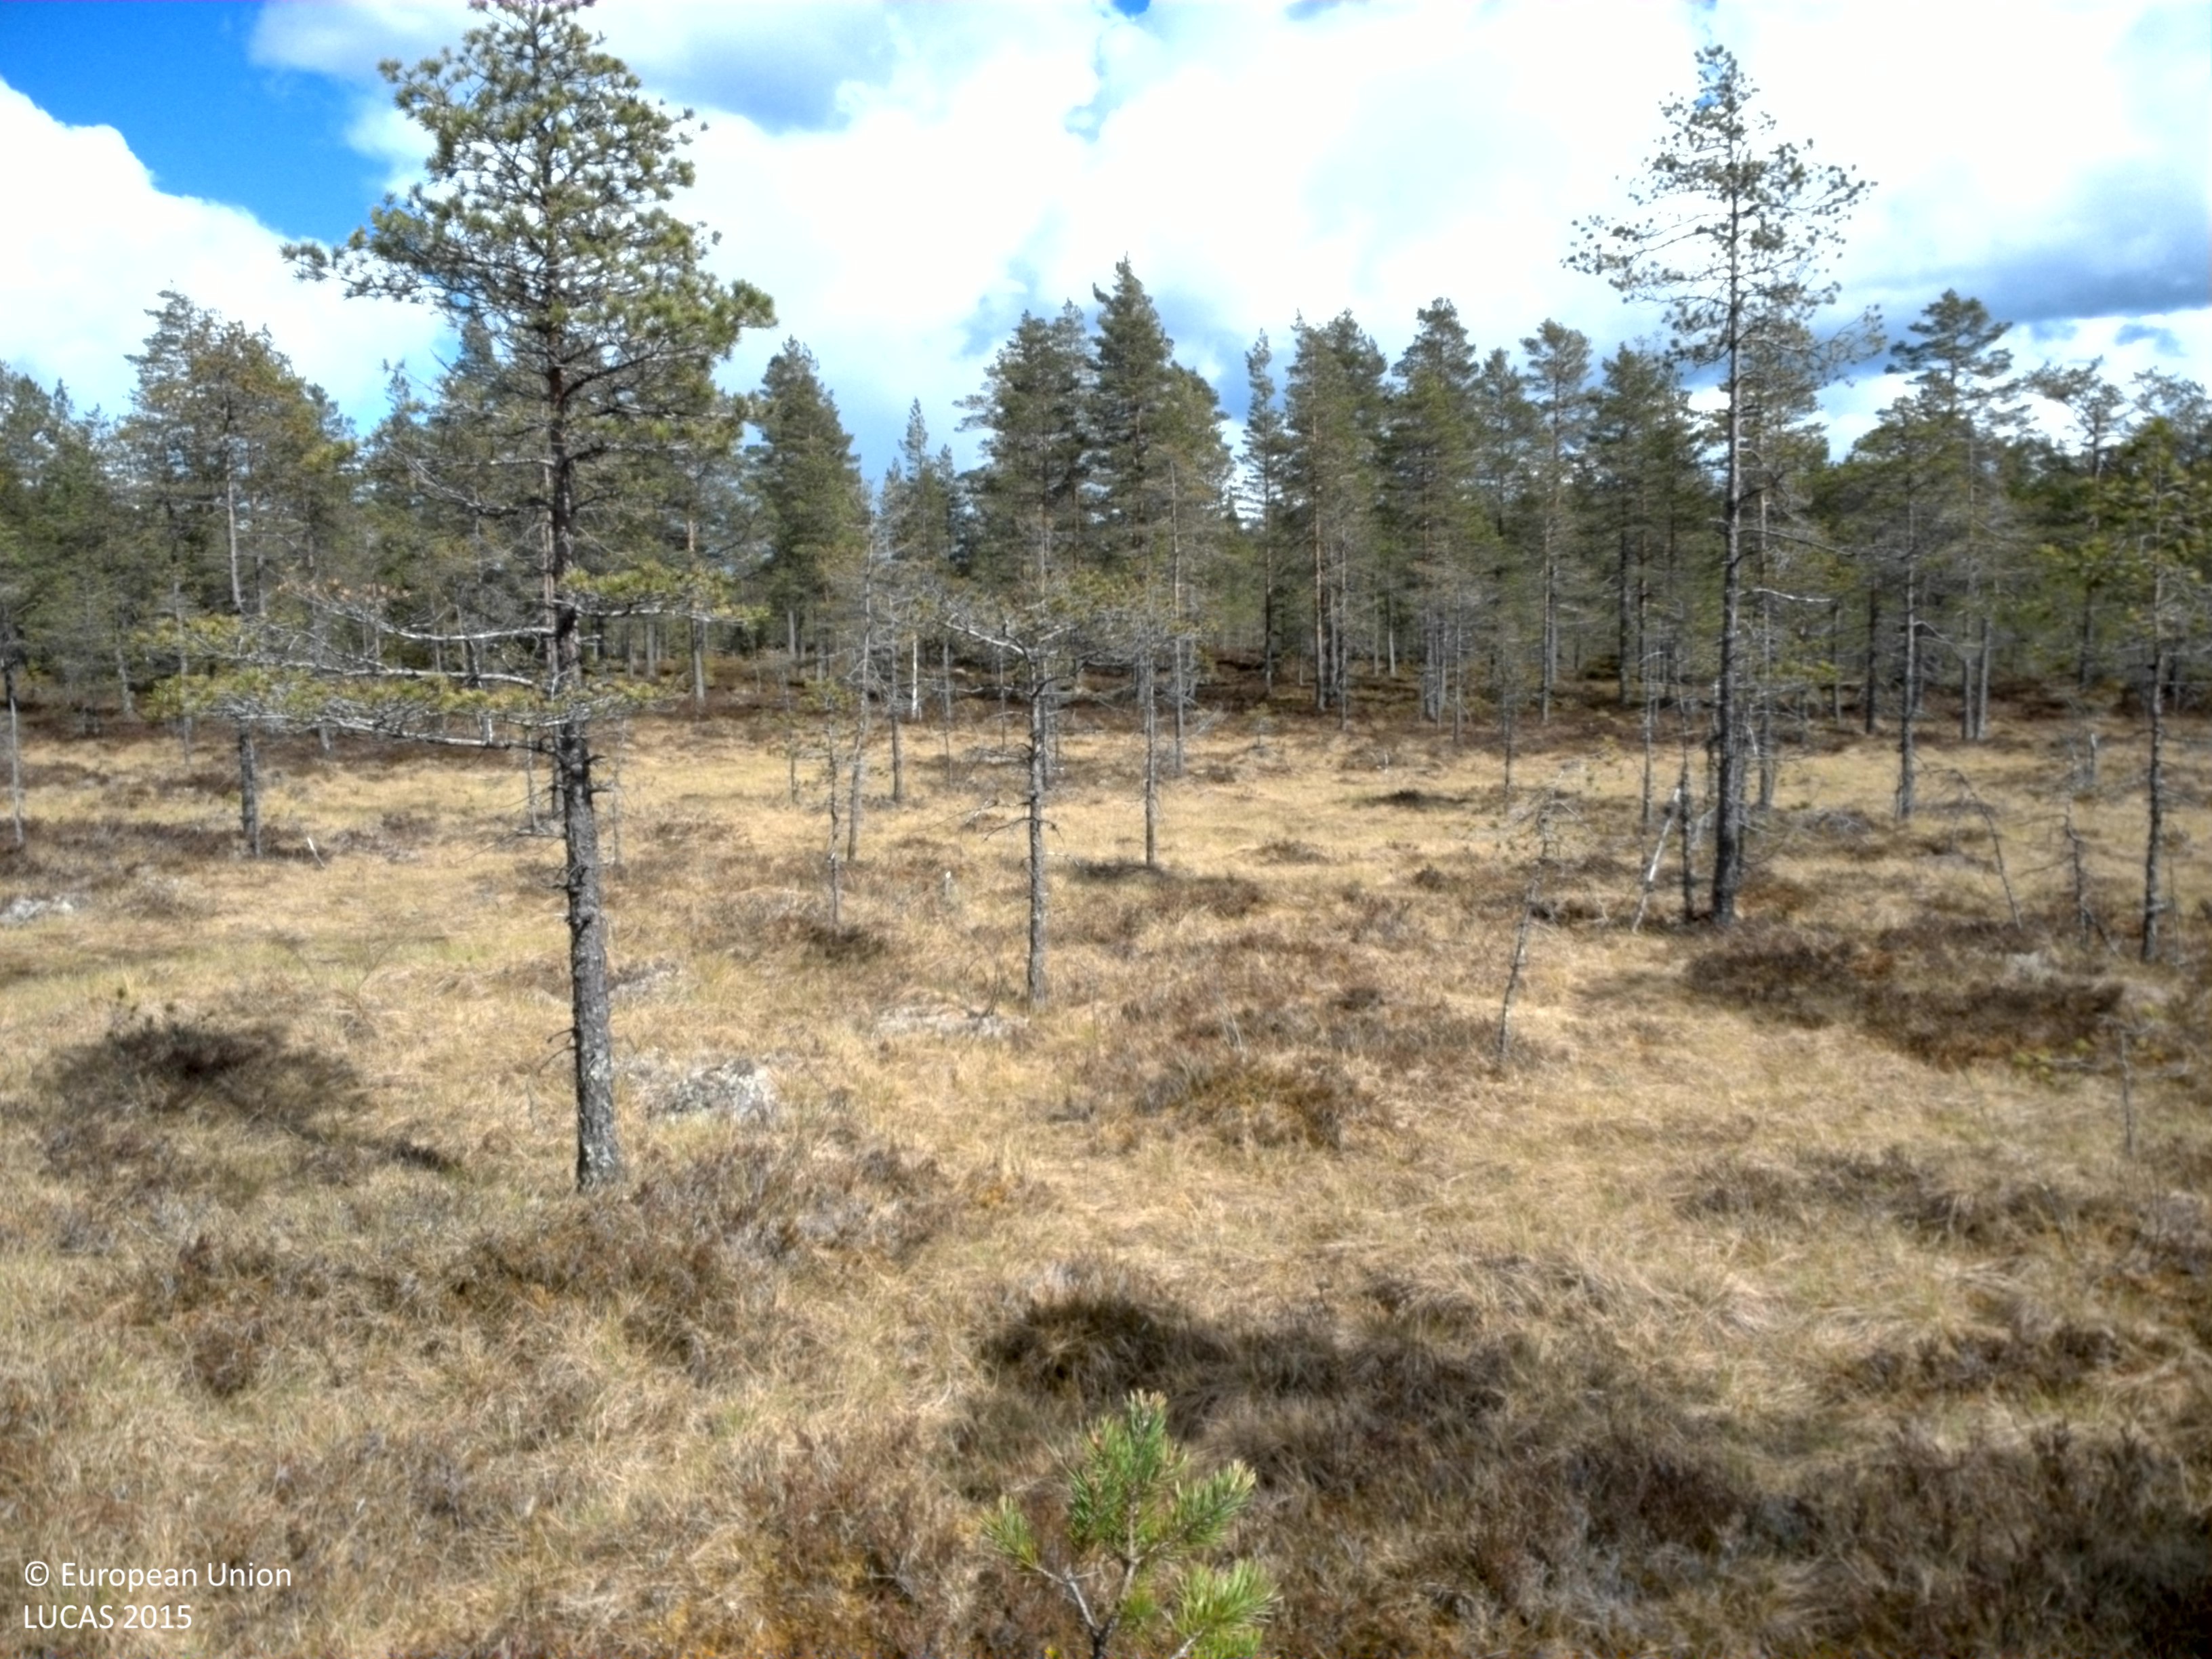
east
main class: Woodland
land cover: Pine dominated coniferous woodland
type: mire and swamp forests
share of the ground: 10 - 25 %
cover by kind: herbaceous plants 45 %, shrubs 40 %, coniferous forest trees 15 %
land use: Semi-natural and natural areas not in use
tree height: > 5 m
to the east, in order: Pine dominated coniferous woodland; Peatbogs; Pine dominated coniferous woodland; Pine dominated mixed woodland; Ditches and canals; Paved roads, cycling and walking lanes; Ditches and canals; Pine dominated mixed woodland; Pine dominated coniferous woodland; Pine dominated mixed woodland; Spruce dominated mixed woodland; Electric lines; Spruce dominated mixed woodland; Other coniferous woodland
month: May
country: SE
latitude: 60.4059
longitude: 13.5659
